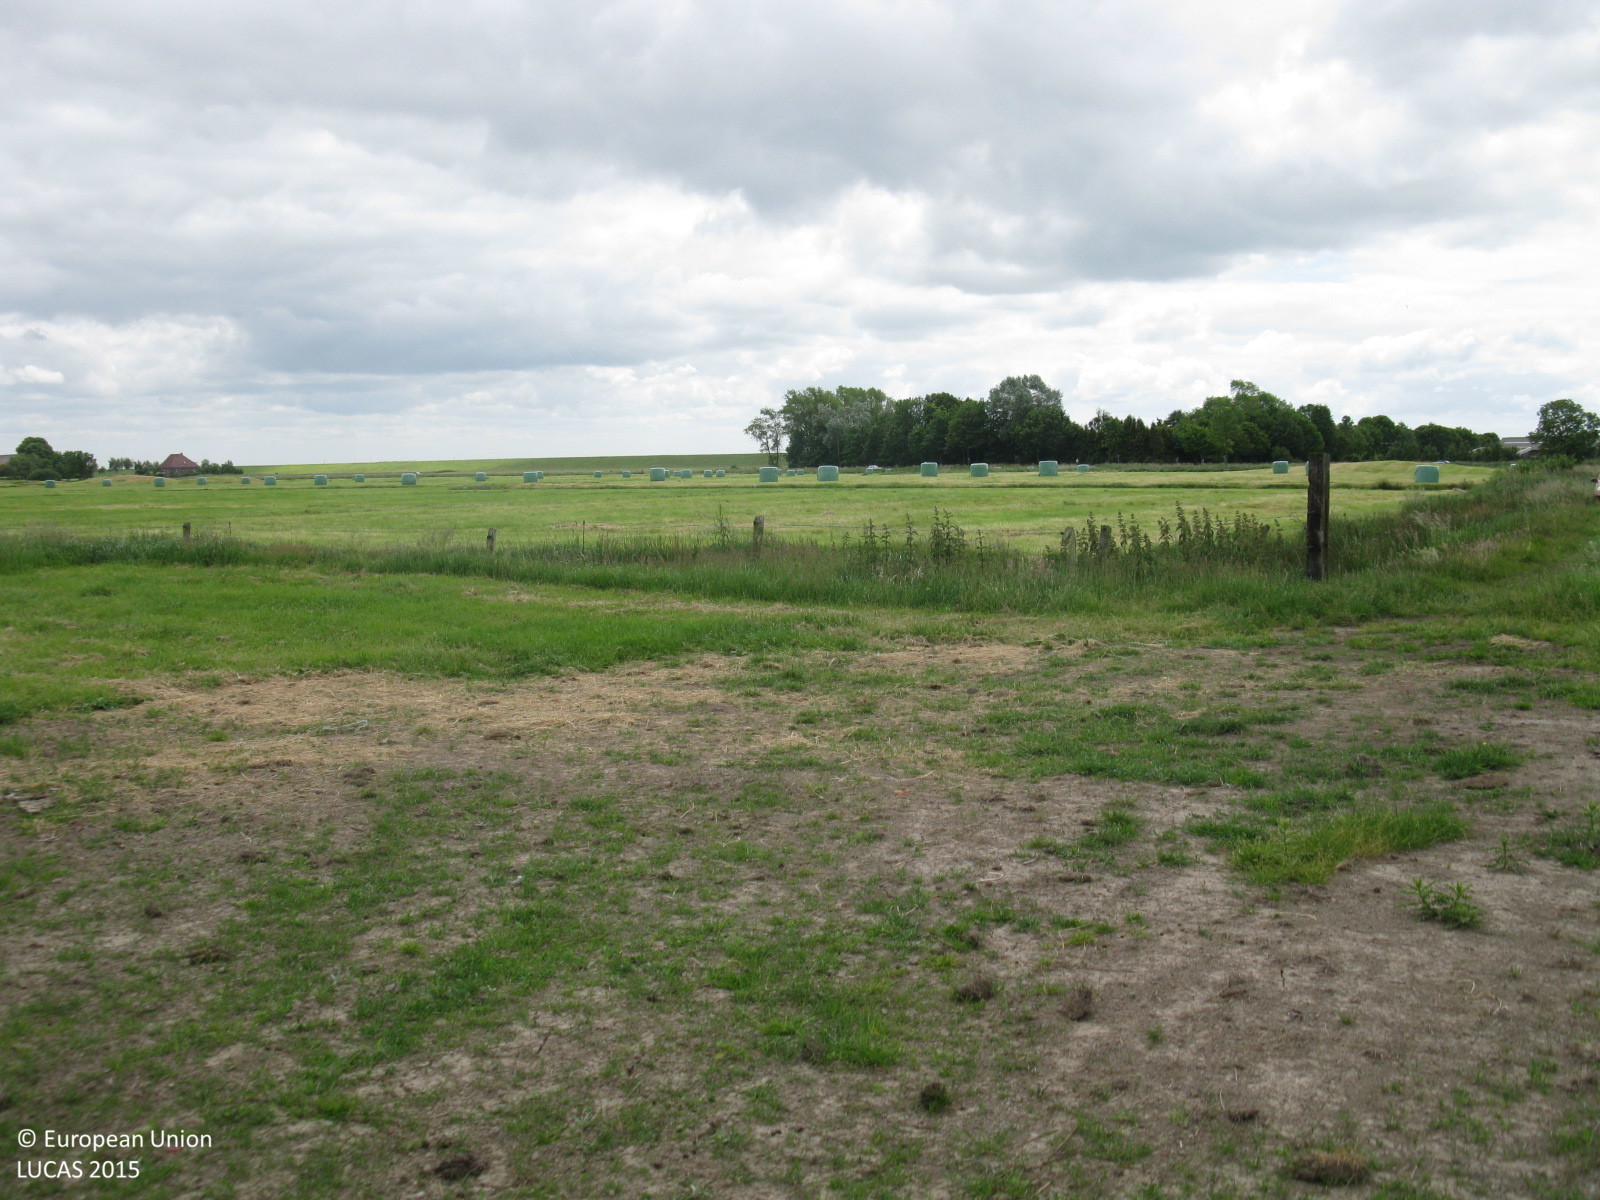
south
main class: Grassland
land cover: Grassland without tree/shrub cover
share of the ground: > 75 %
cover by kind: herbaceous plants 100 %
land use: Agriculture (excluding fallow land and kitchen gardens)
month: June
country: DE
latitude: 53.3355
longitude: 7.2824
